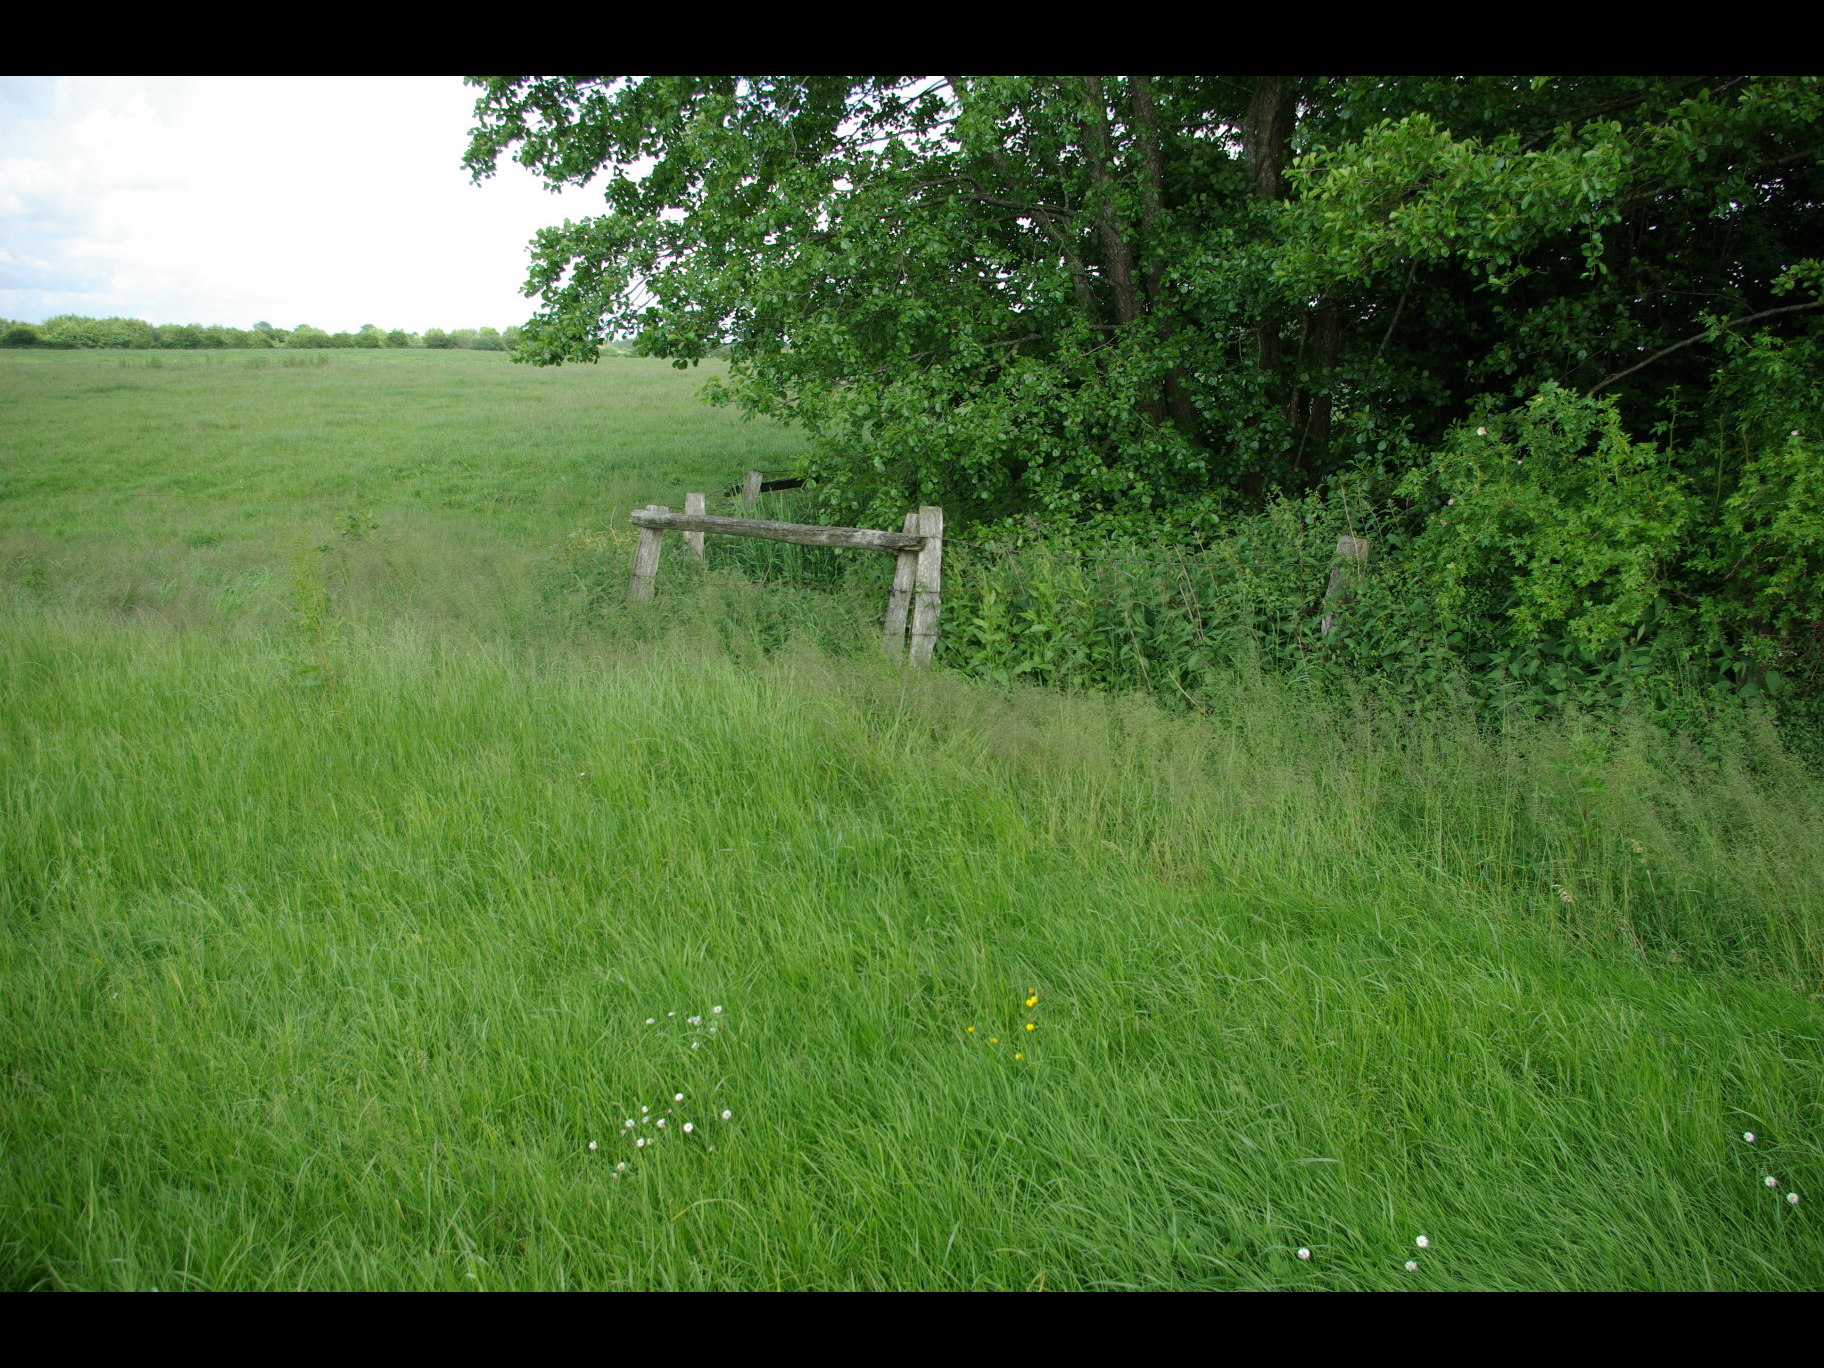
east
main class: Grassland
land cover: Grassland without tree/shrub cover
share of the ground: > 75 %
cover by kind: herbaceous plants 100 %
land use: Agriculture (excluding fallow land and kitchen gardens)
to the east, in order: Grassland without tree/shrub cover; Fences; Spontaneously vegetated surfaces; Broadleaved woodland; Fences; Grassland without tree/shrub cover
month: June
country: DE
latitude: 54.2107
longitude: 9.9540
